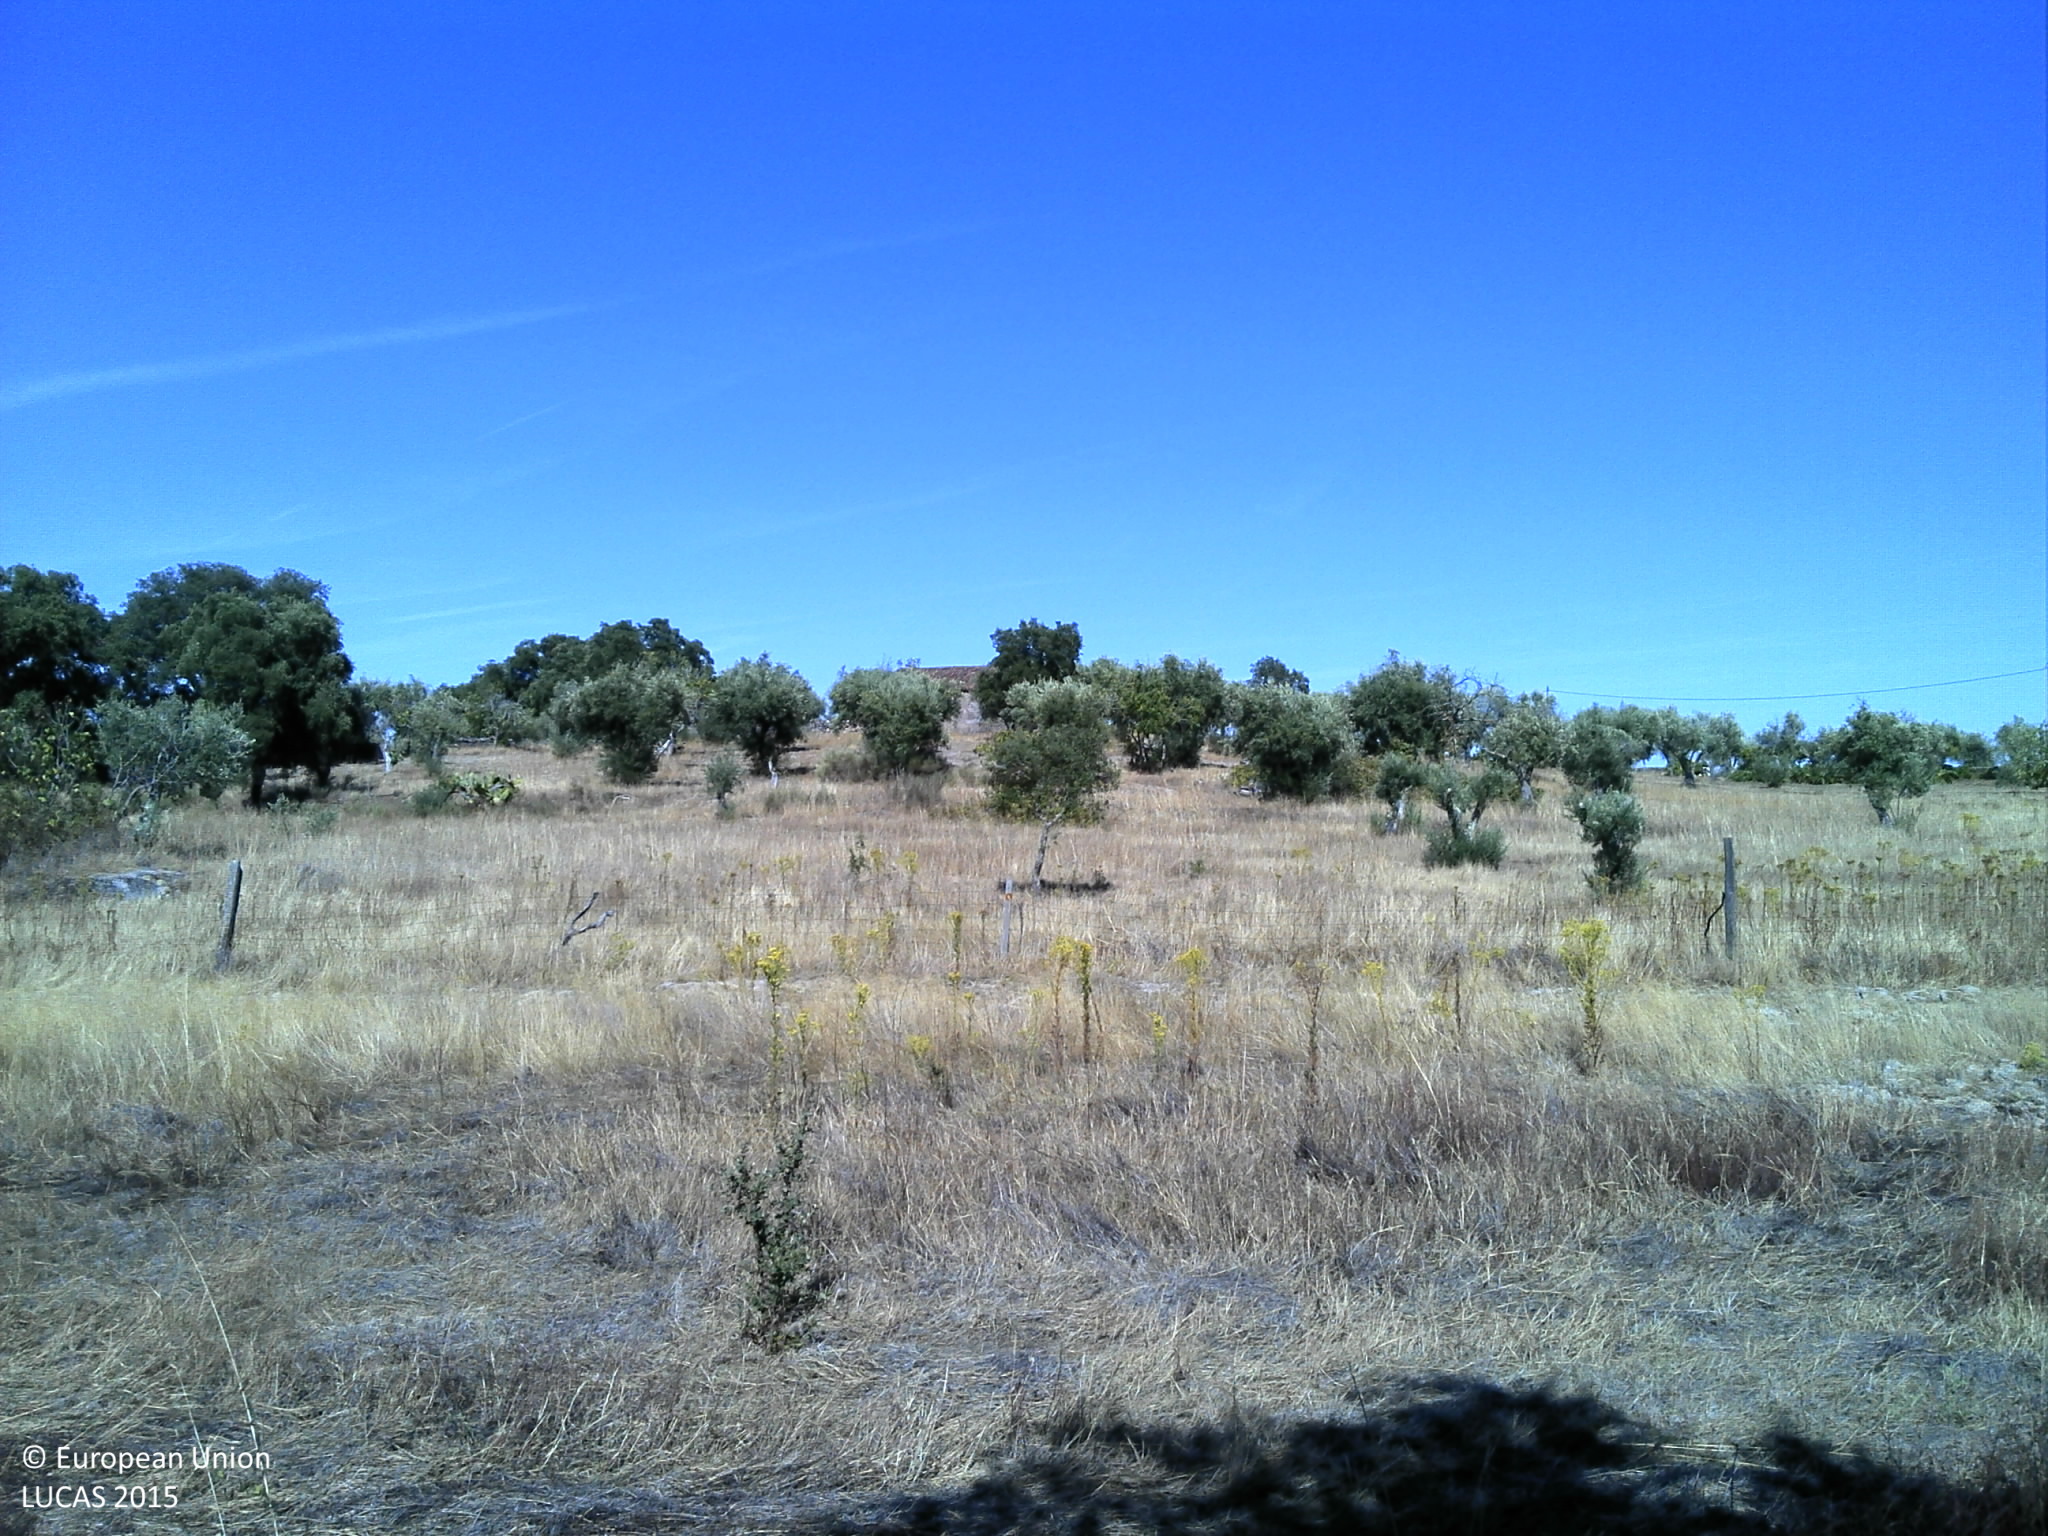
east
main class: Cropland
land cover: Olive groves
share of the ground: 10 - 25 %
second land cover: Grassland without tree/shrub cover
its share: 10 - 25 %
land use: Agriculture (excluding fallow land and kitchen gardens)
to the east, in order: Olive groves; Grassland without tree/shrub cover; Olive groves; Fences; Olive groves; Fences; Olive groves; Fences; Olive groves; Tracks; Dry stone walls; Electric lines; Paved roads, cycling and walking lanes; Ditches and canals; Dry stone walls; Grassland without tree/shrub cover; Rock outcrops; Grassland without tree/shrub cover; Vineyards
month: August
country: PT
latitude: 39.5063
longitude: -7.5275
